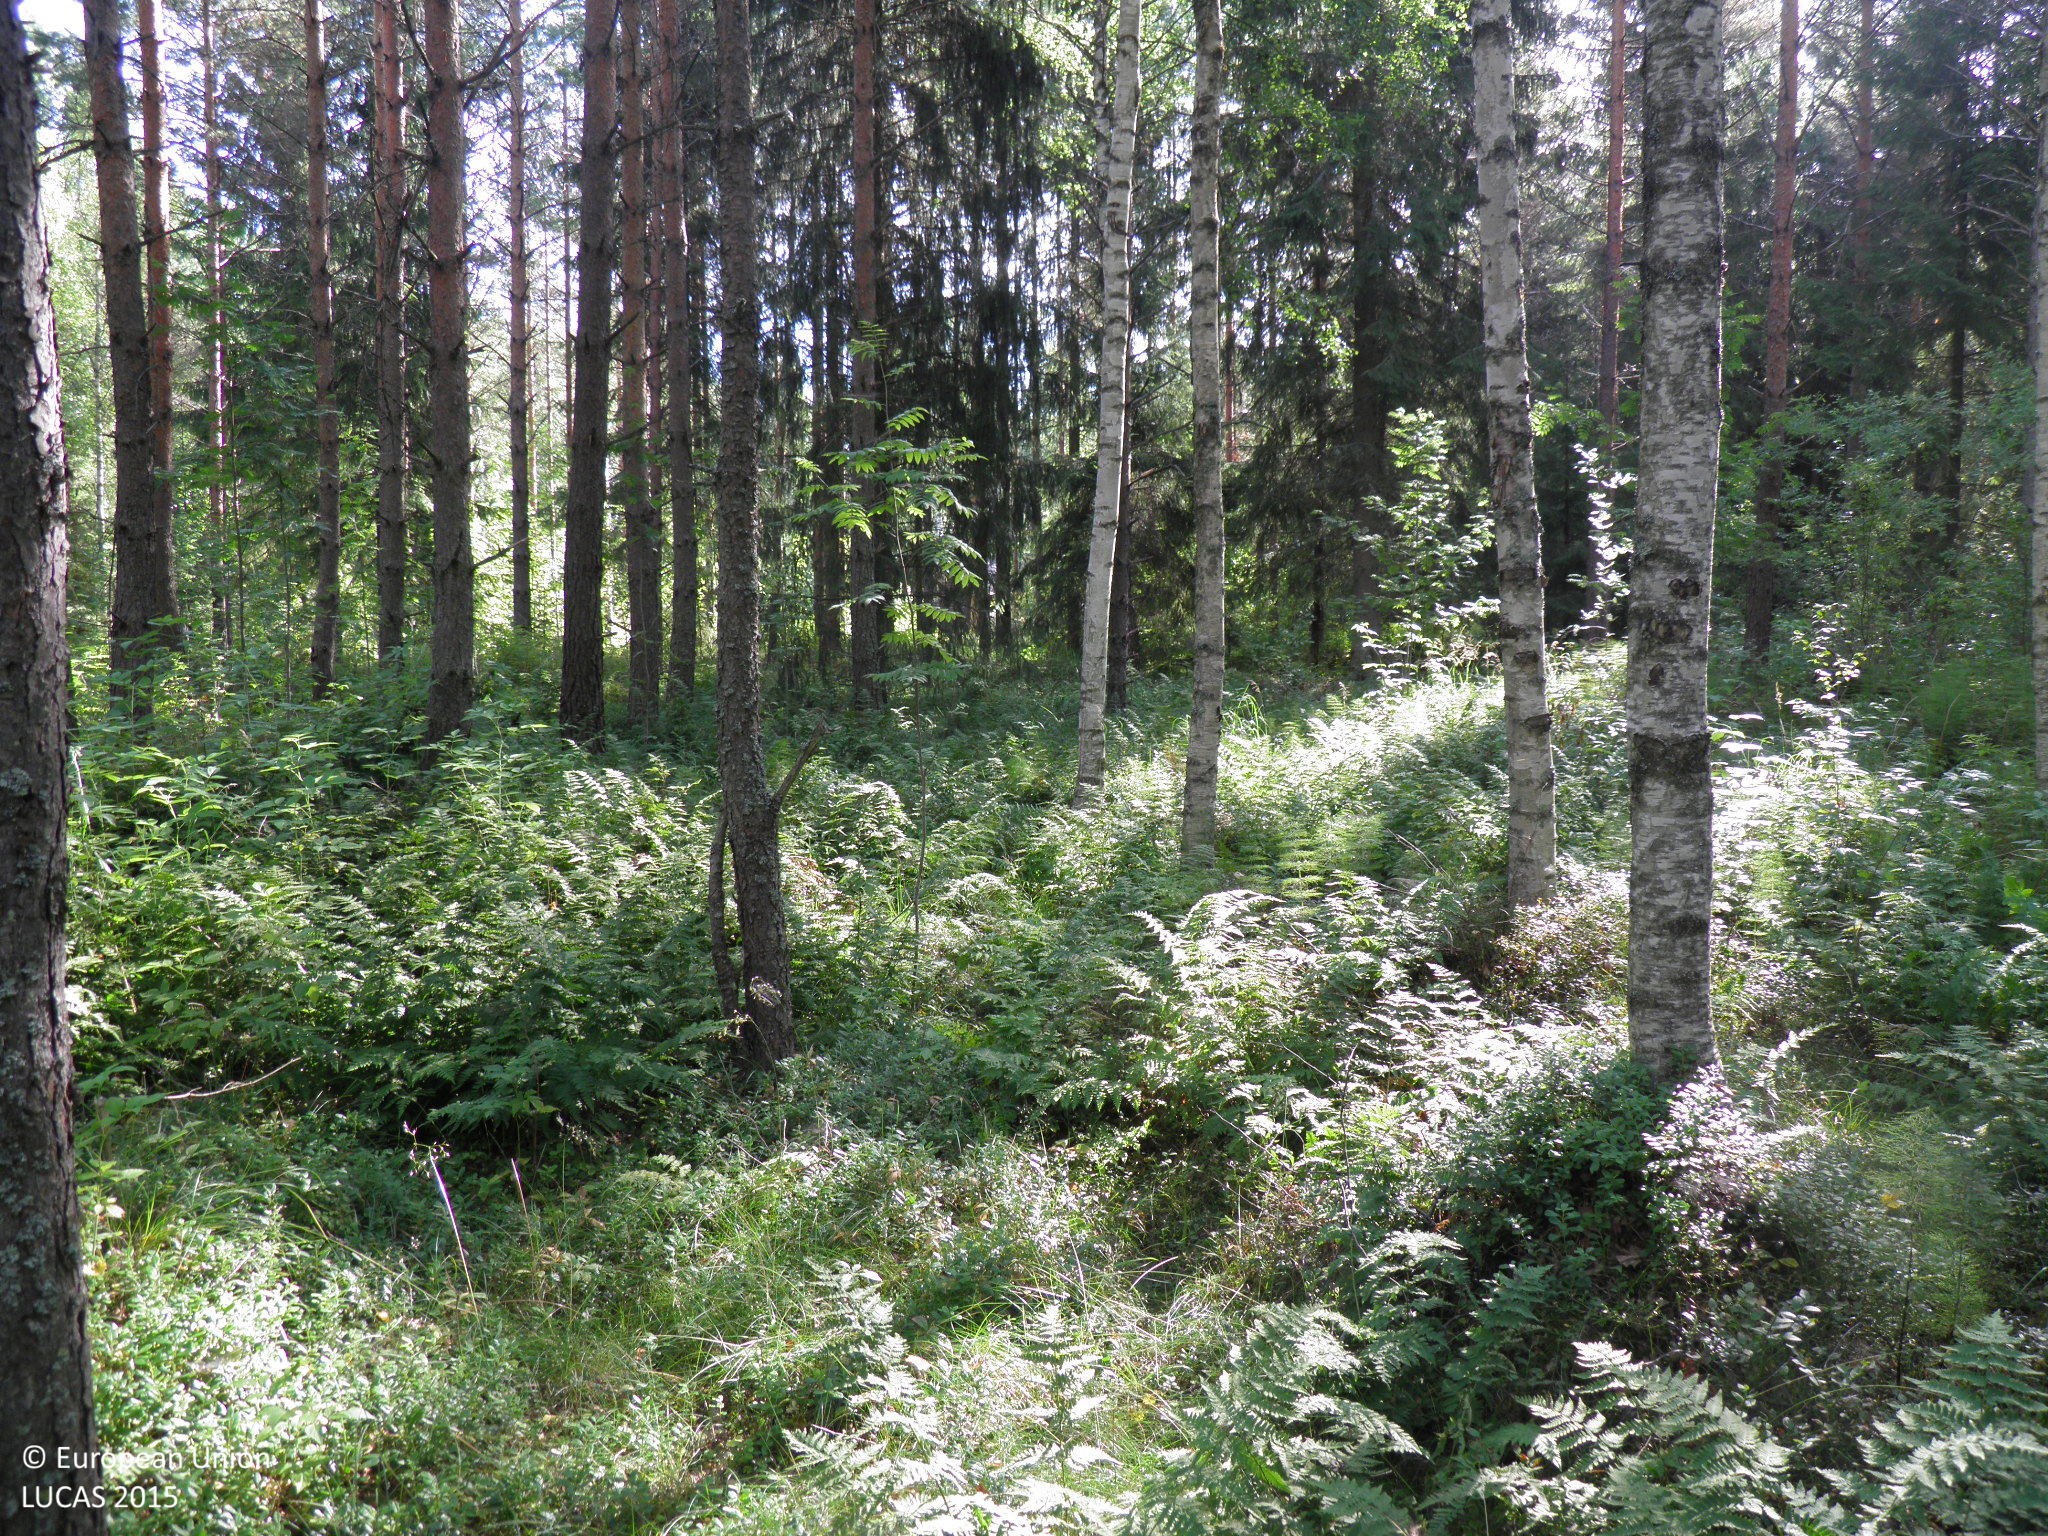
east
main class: Woodland
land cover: Pine dominated mixed woodland
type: hemiboreal forest and nemoral coniferous forest and mixed broadleaved-coniferous forest
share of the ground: > 75 %
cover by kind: broadleaved forest trees 50 %, coniferous forest trees 25 %, shrubs 25 %
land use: Forestry
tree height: > 5 m
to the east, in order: Pine dominated mixed woodland; Ditches and canals; Pine dominated mixed woodland; Paved roads, cycling and walking lanes; Pine dominated coniferous woodland; Artificial constructions in urban areas; Spruce dominated mixed woodland; Ditches and canals; Other mixed woodland
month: August
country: FI
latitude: 61.0411
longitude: 22.5651
